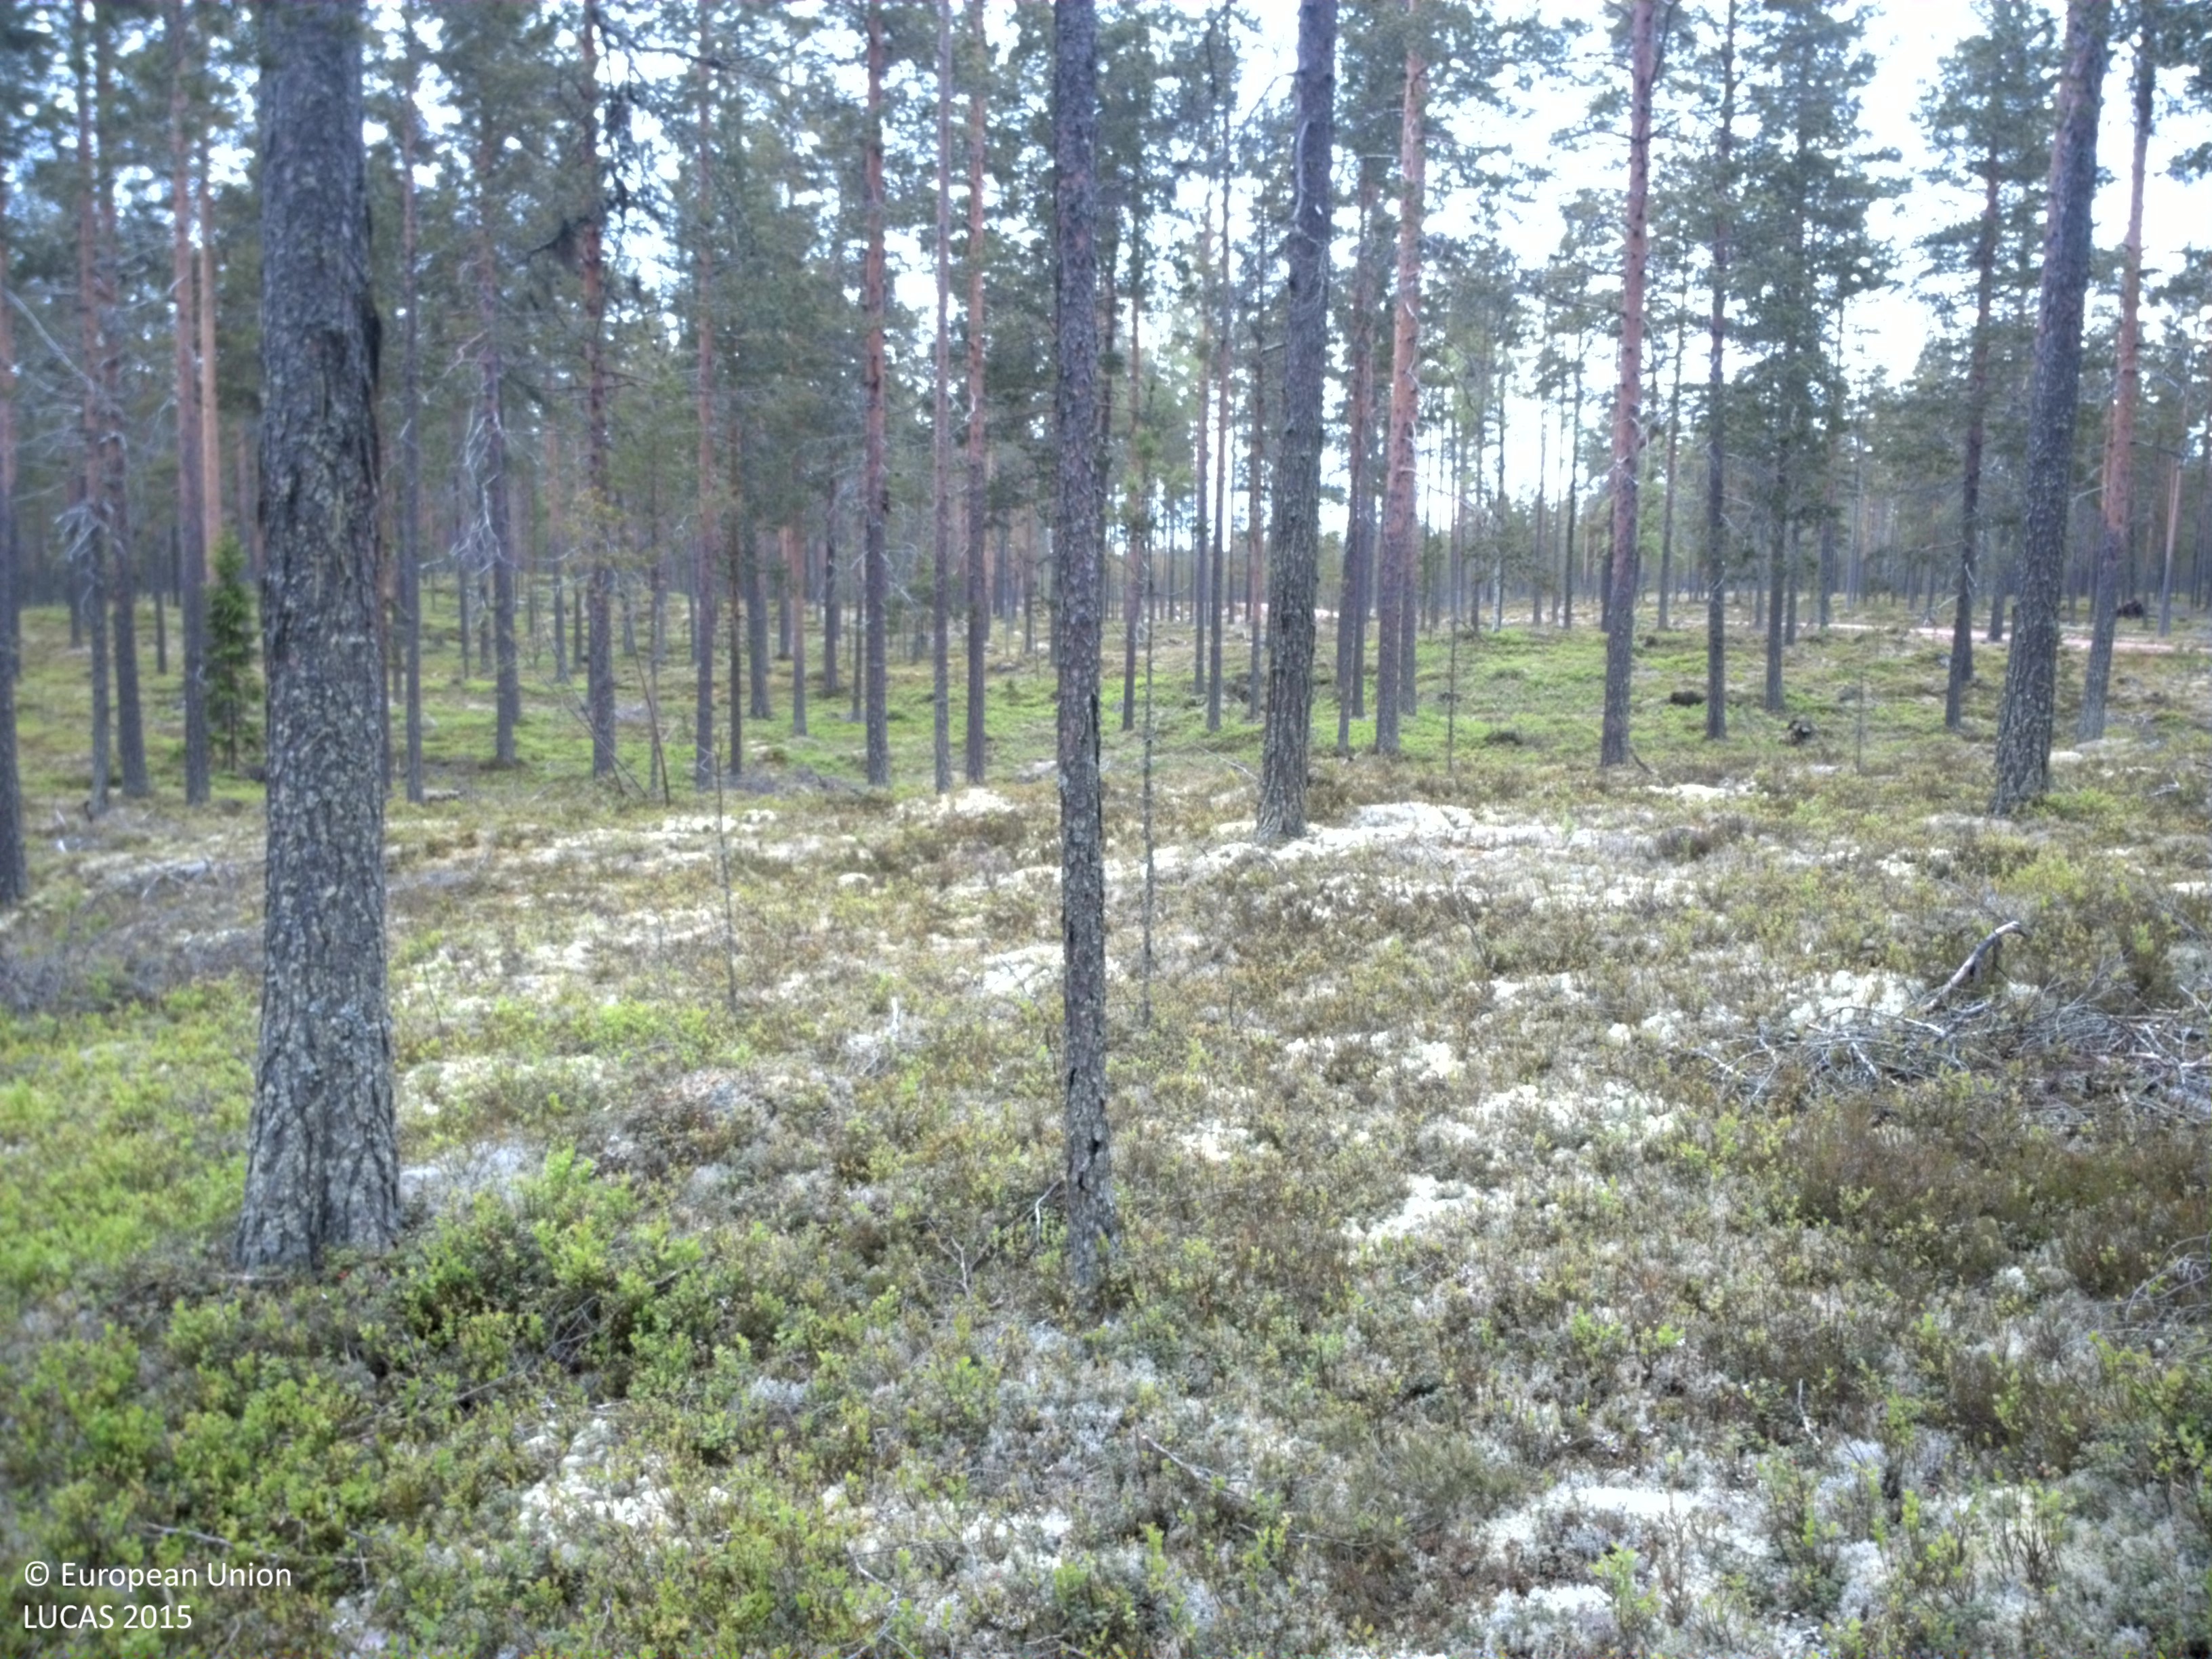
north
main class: Woodland
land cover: Pine dominated coniferous woodland
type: boreal forest
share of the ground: 50 - 75 %
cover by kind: coniferous forest trees 65 %, herbaceous plants 20 %, lichens and mosses 15 %
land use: Forestry
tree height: > 5 m
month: June
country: SE
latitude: 61.2878
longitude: 13.6262
